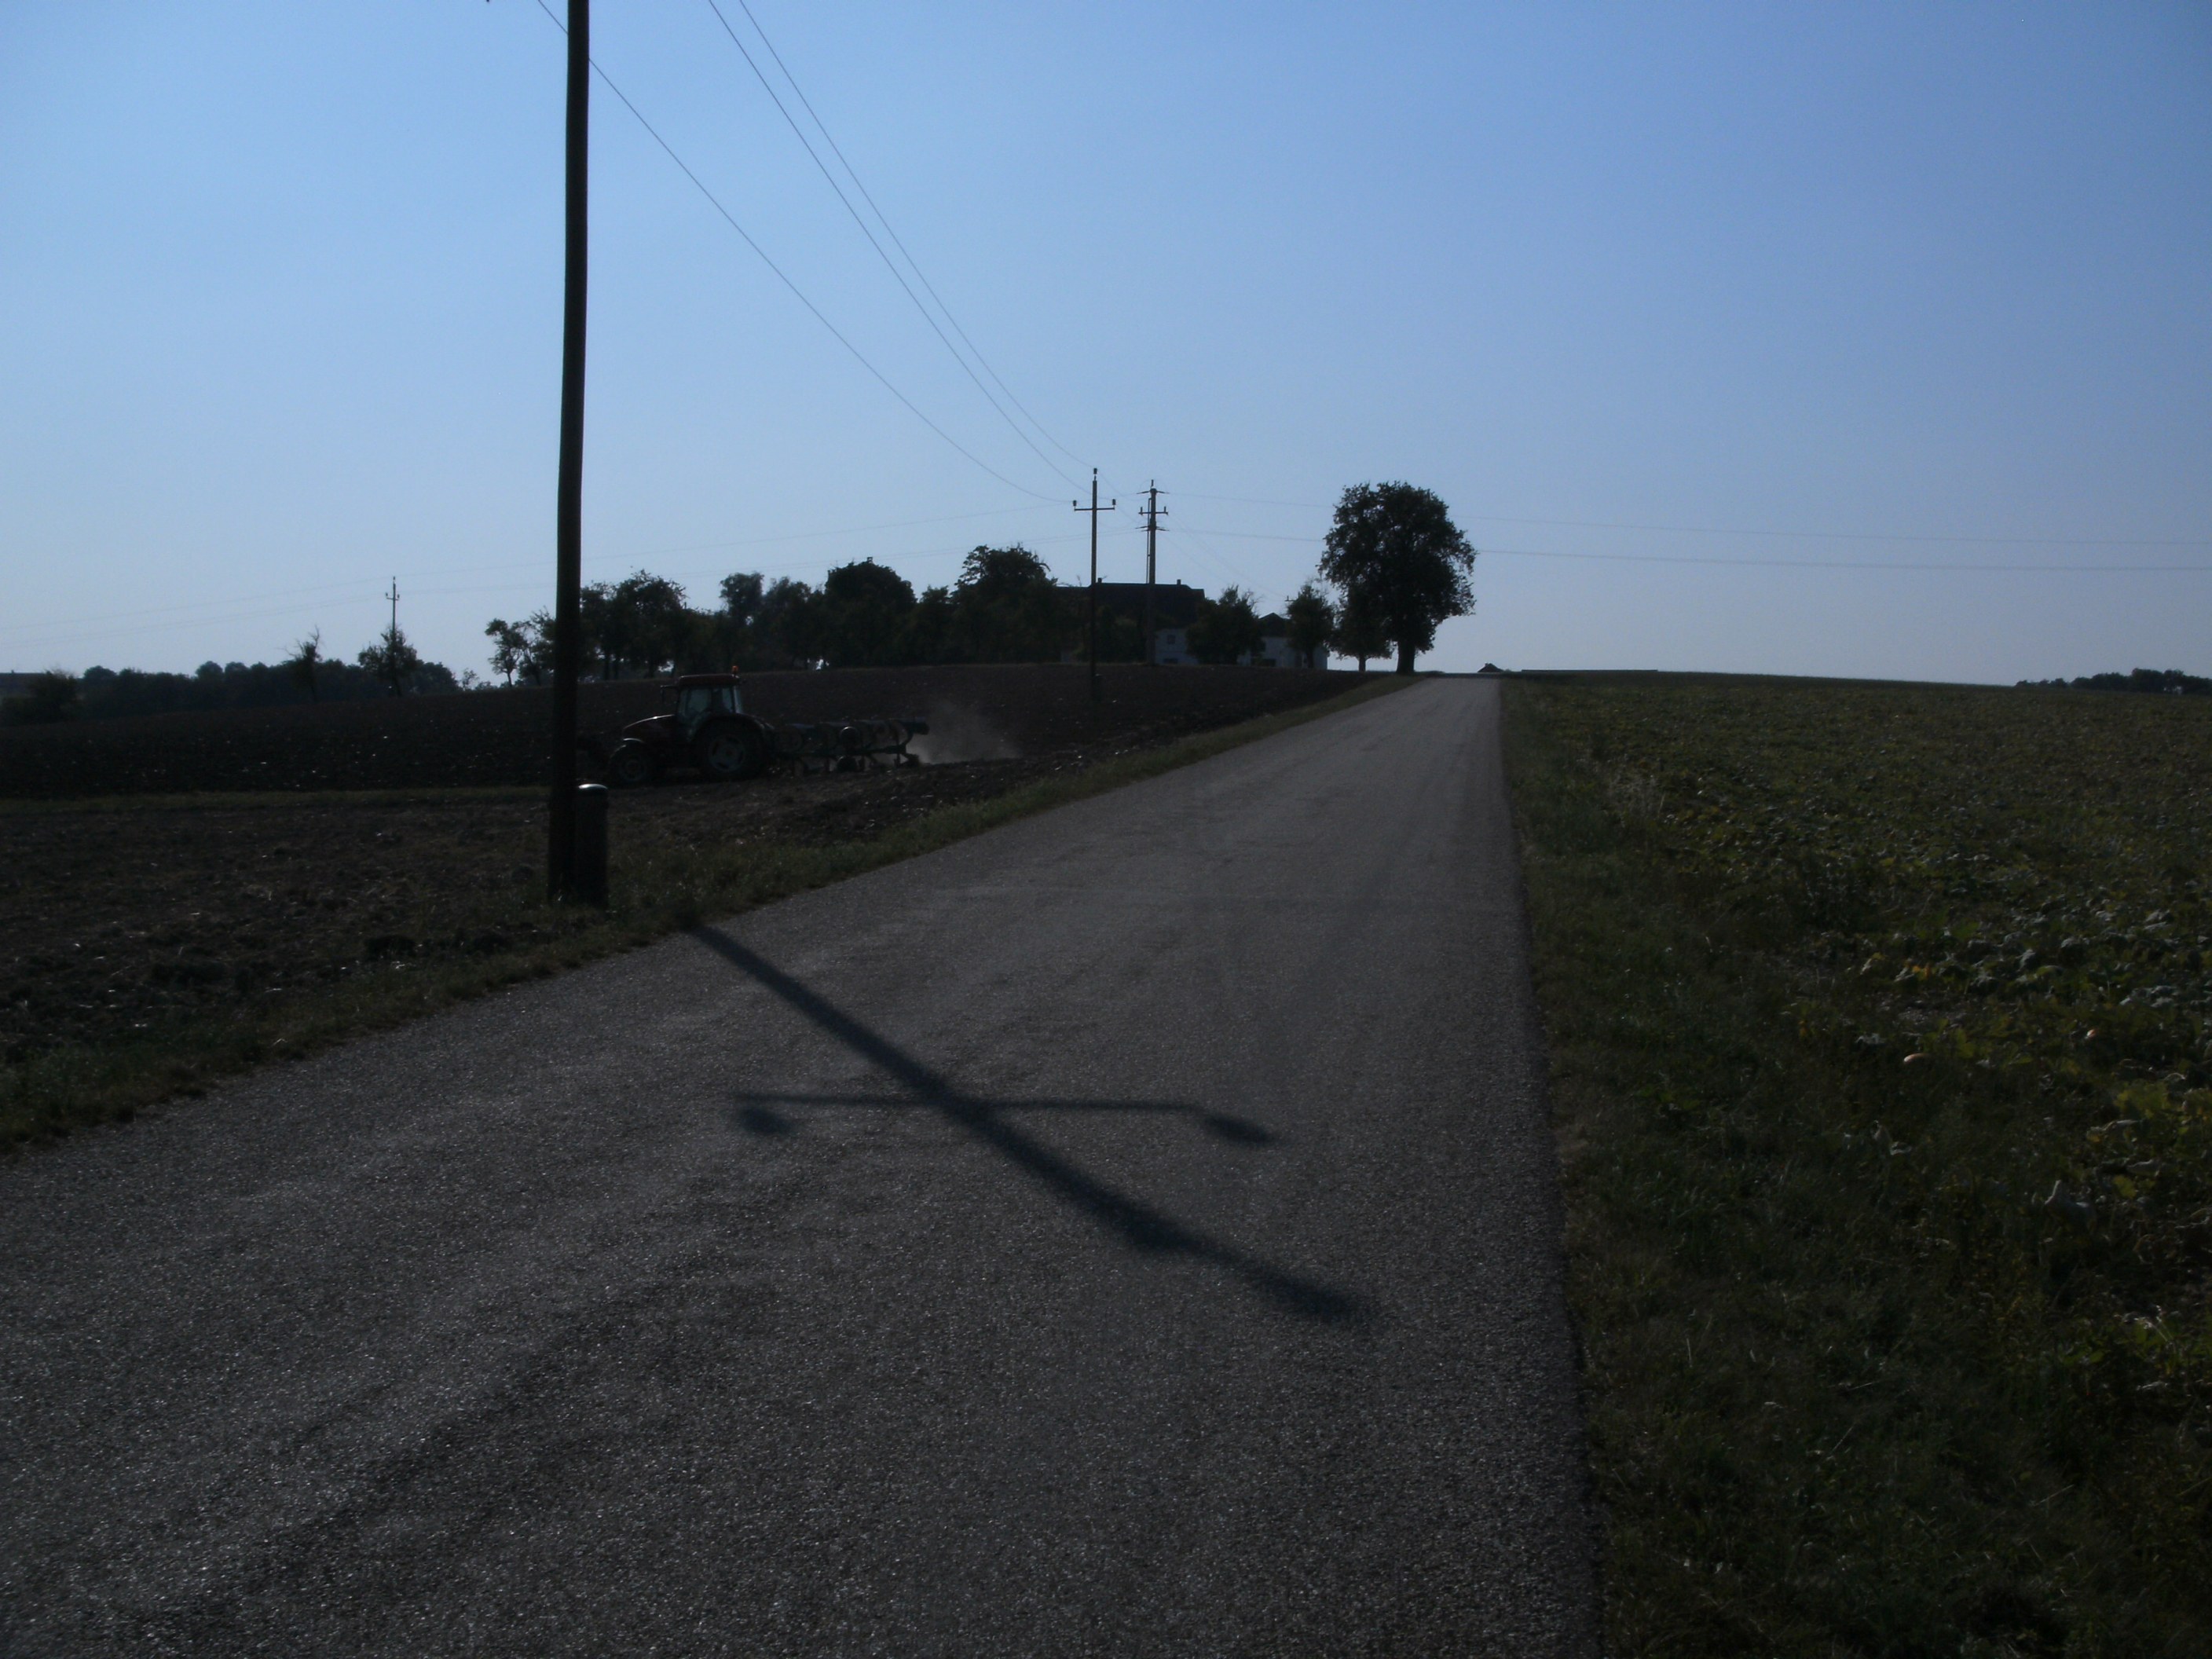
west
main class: Cropland
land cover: Other fresh vegetables
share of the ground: > 75 %
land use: Agriculture (excluding fallow land and kitchen gardens)
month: August
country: AT
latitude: 48.3475
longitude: 13.5212
